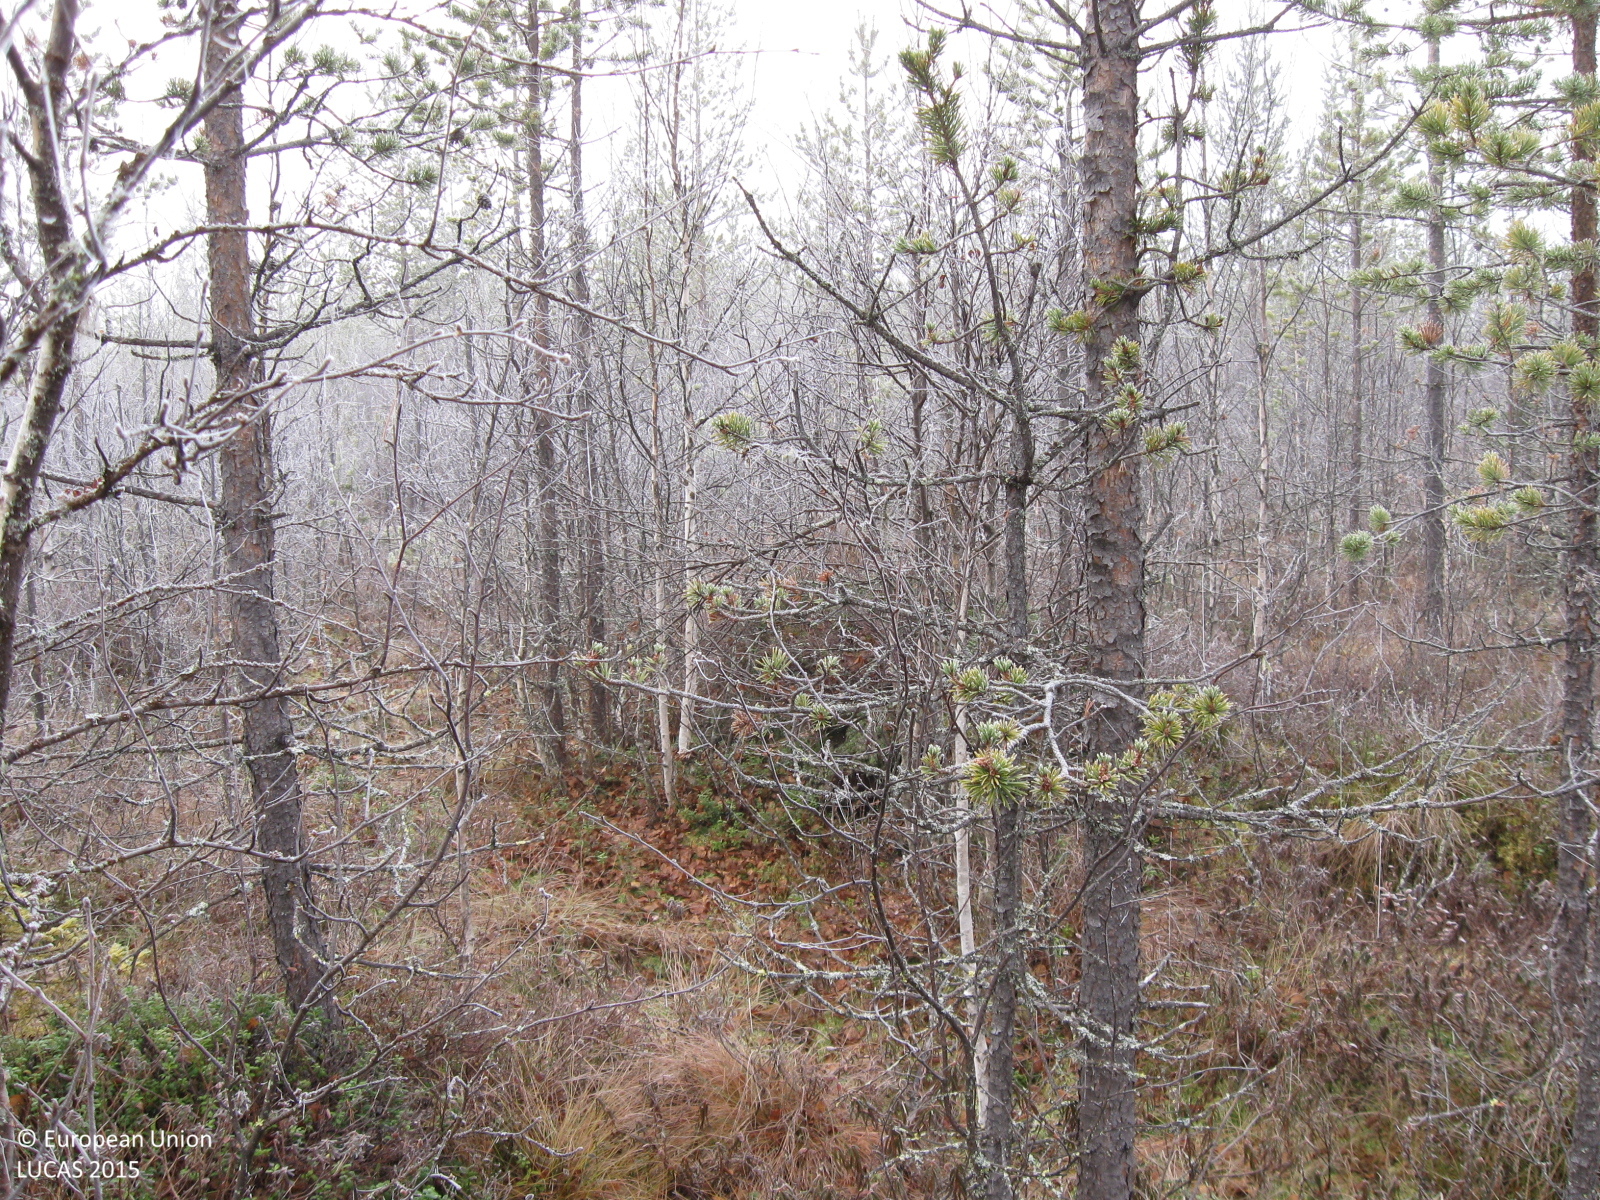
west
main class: Woodland
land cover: Pine dominated mixed woodland
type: mire and swamp forests
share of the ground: 50 - 75 %
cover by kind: coniferous forest trees 35 %, shrubs 30 %, broadleaved forest trees 15 %, herbaceous plants 10 %, lichens and mosses 10 %
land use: Forestry
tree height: < 5 m
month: October
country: SE
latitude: 66.3605
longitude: 21.7442
